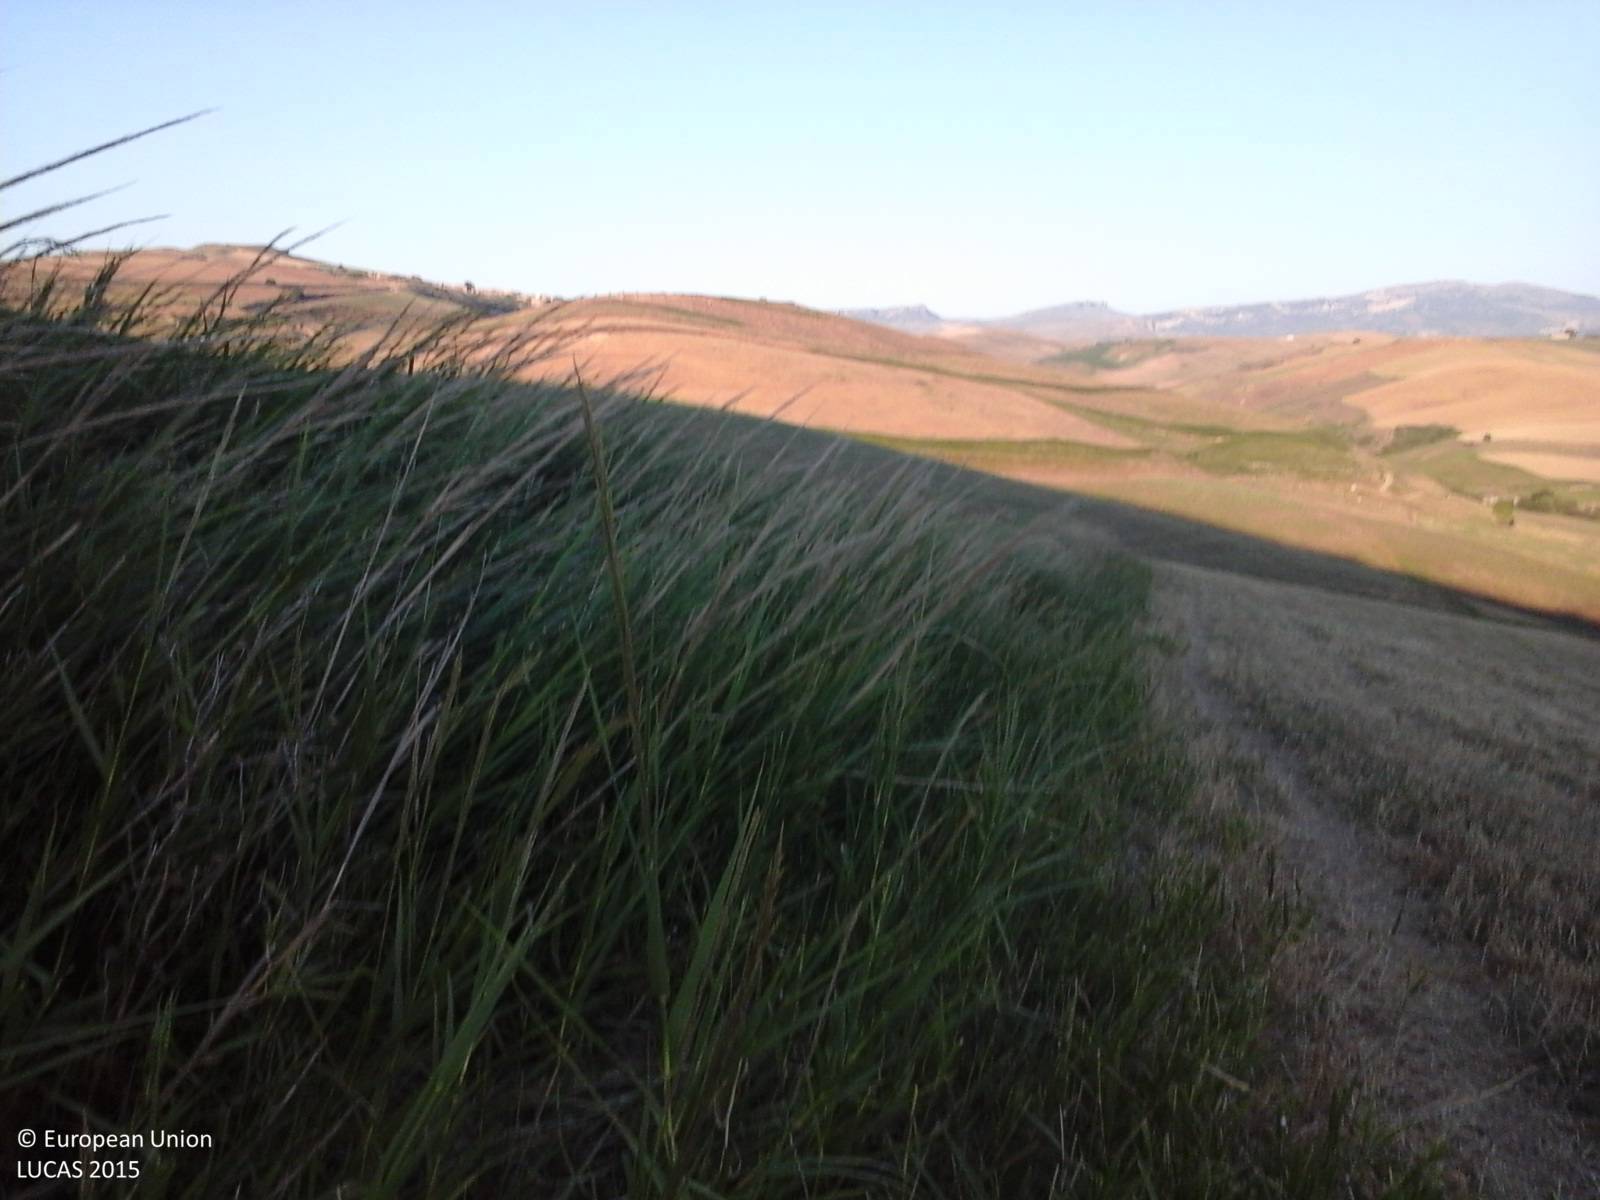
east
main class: Grassland
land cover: Grassland without tree/shrub cover
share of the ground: > 75 %
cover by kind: herbaceous plants 100 %
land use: Agriculture (excluding fallow land and kitchen gardens)
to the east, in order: Grassland without tree/shrub cover; Ditches and canals; Other bare soil; Inland fresh running water; Other bare soil; Inland fresh running water; Spontaneously vegetated surfaces
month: July
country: IT
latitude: 37.7849
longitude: 13.1899
